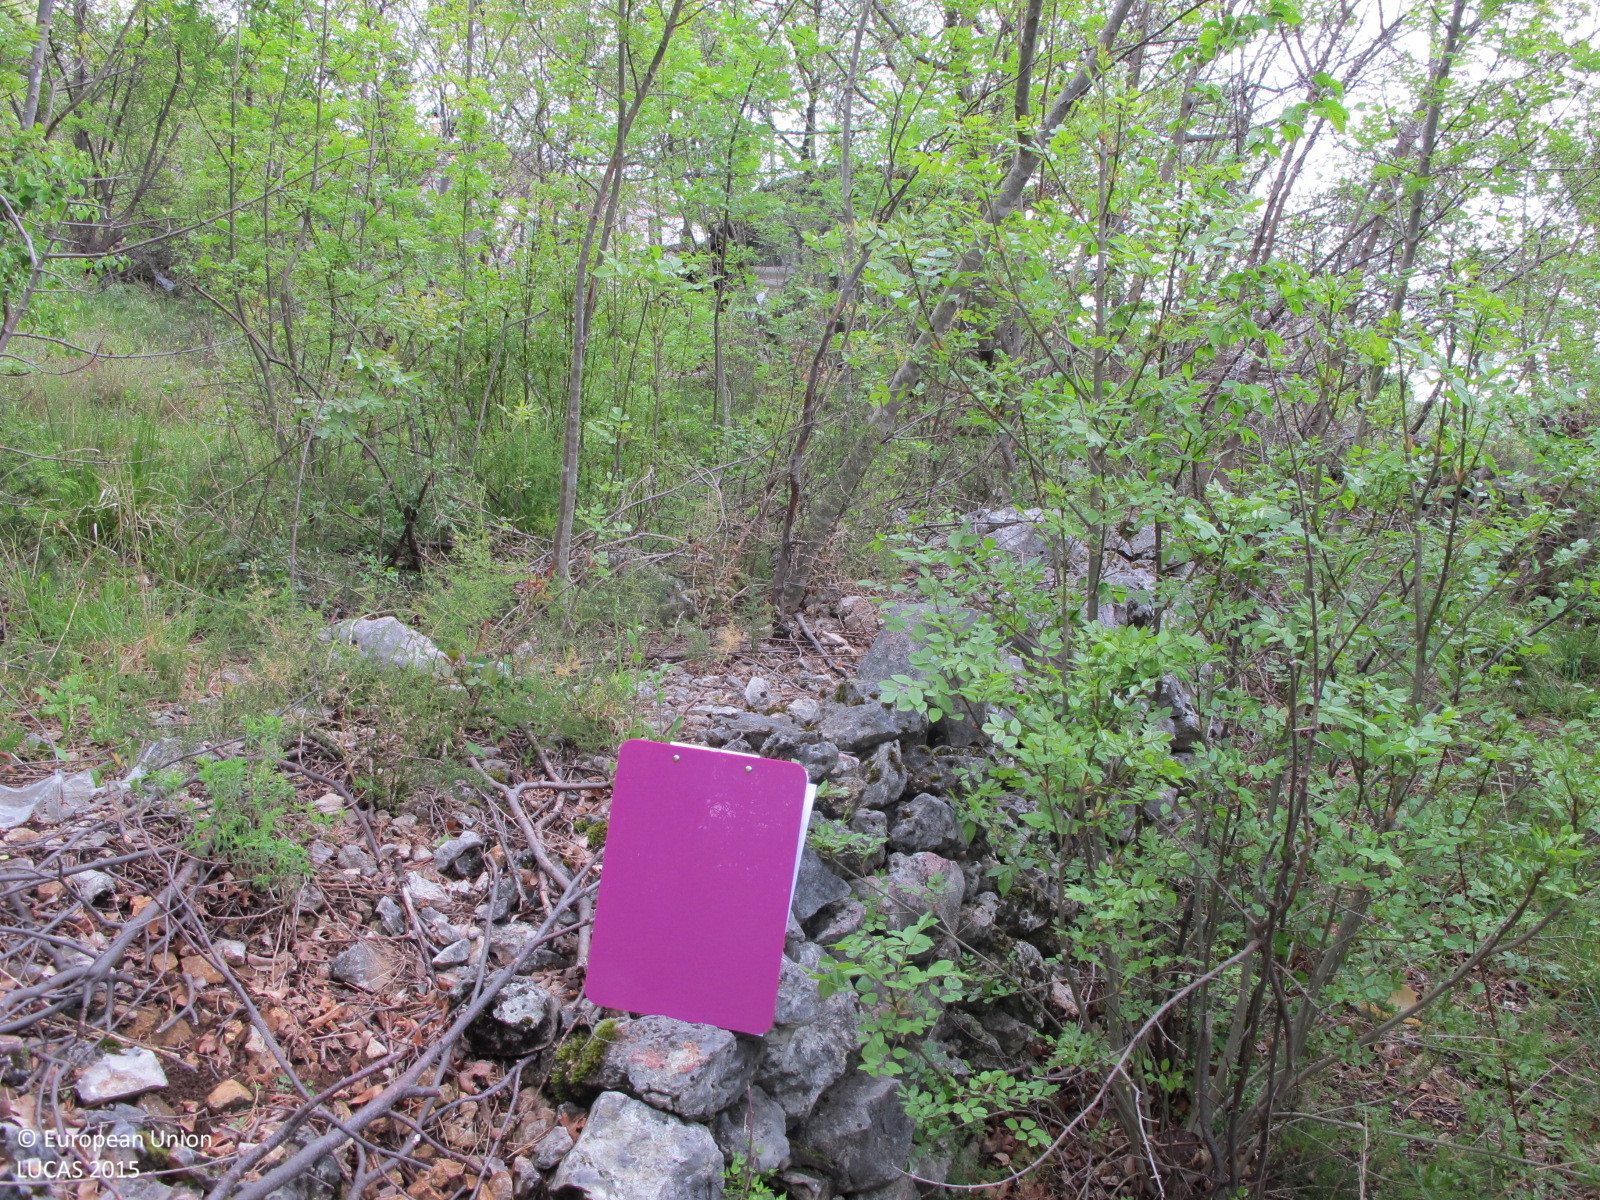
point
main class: Woodland
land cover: Broadleaved woodland
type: acidophilous oak and oak-birch forest
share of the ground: > 75 %
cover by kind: broadleaved forest trees 90 %, coniferous forest trees 5 %, shrubs 5 %
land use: Semi-natural and natural areas not in use
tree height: > 5 m
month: April
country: HR
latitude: 45.2027
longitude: 14.6669
